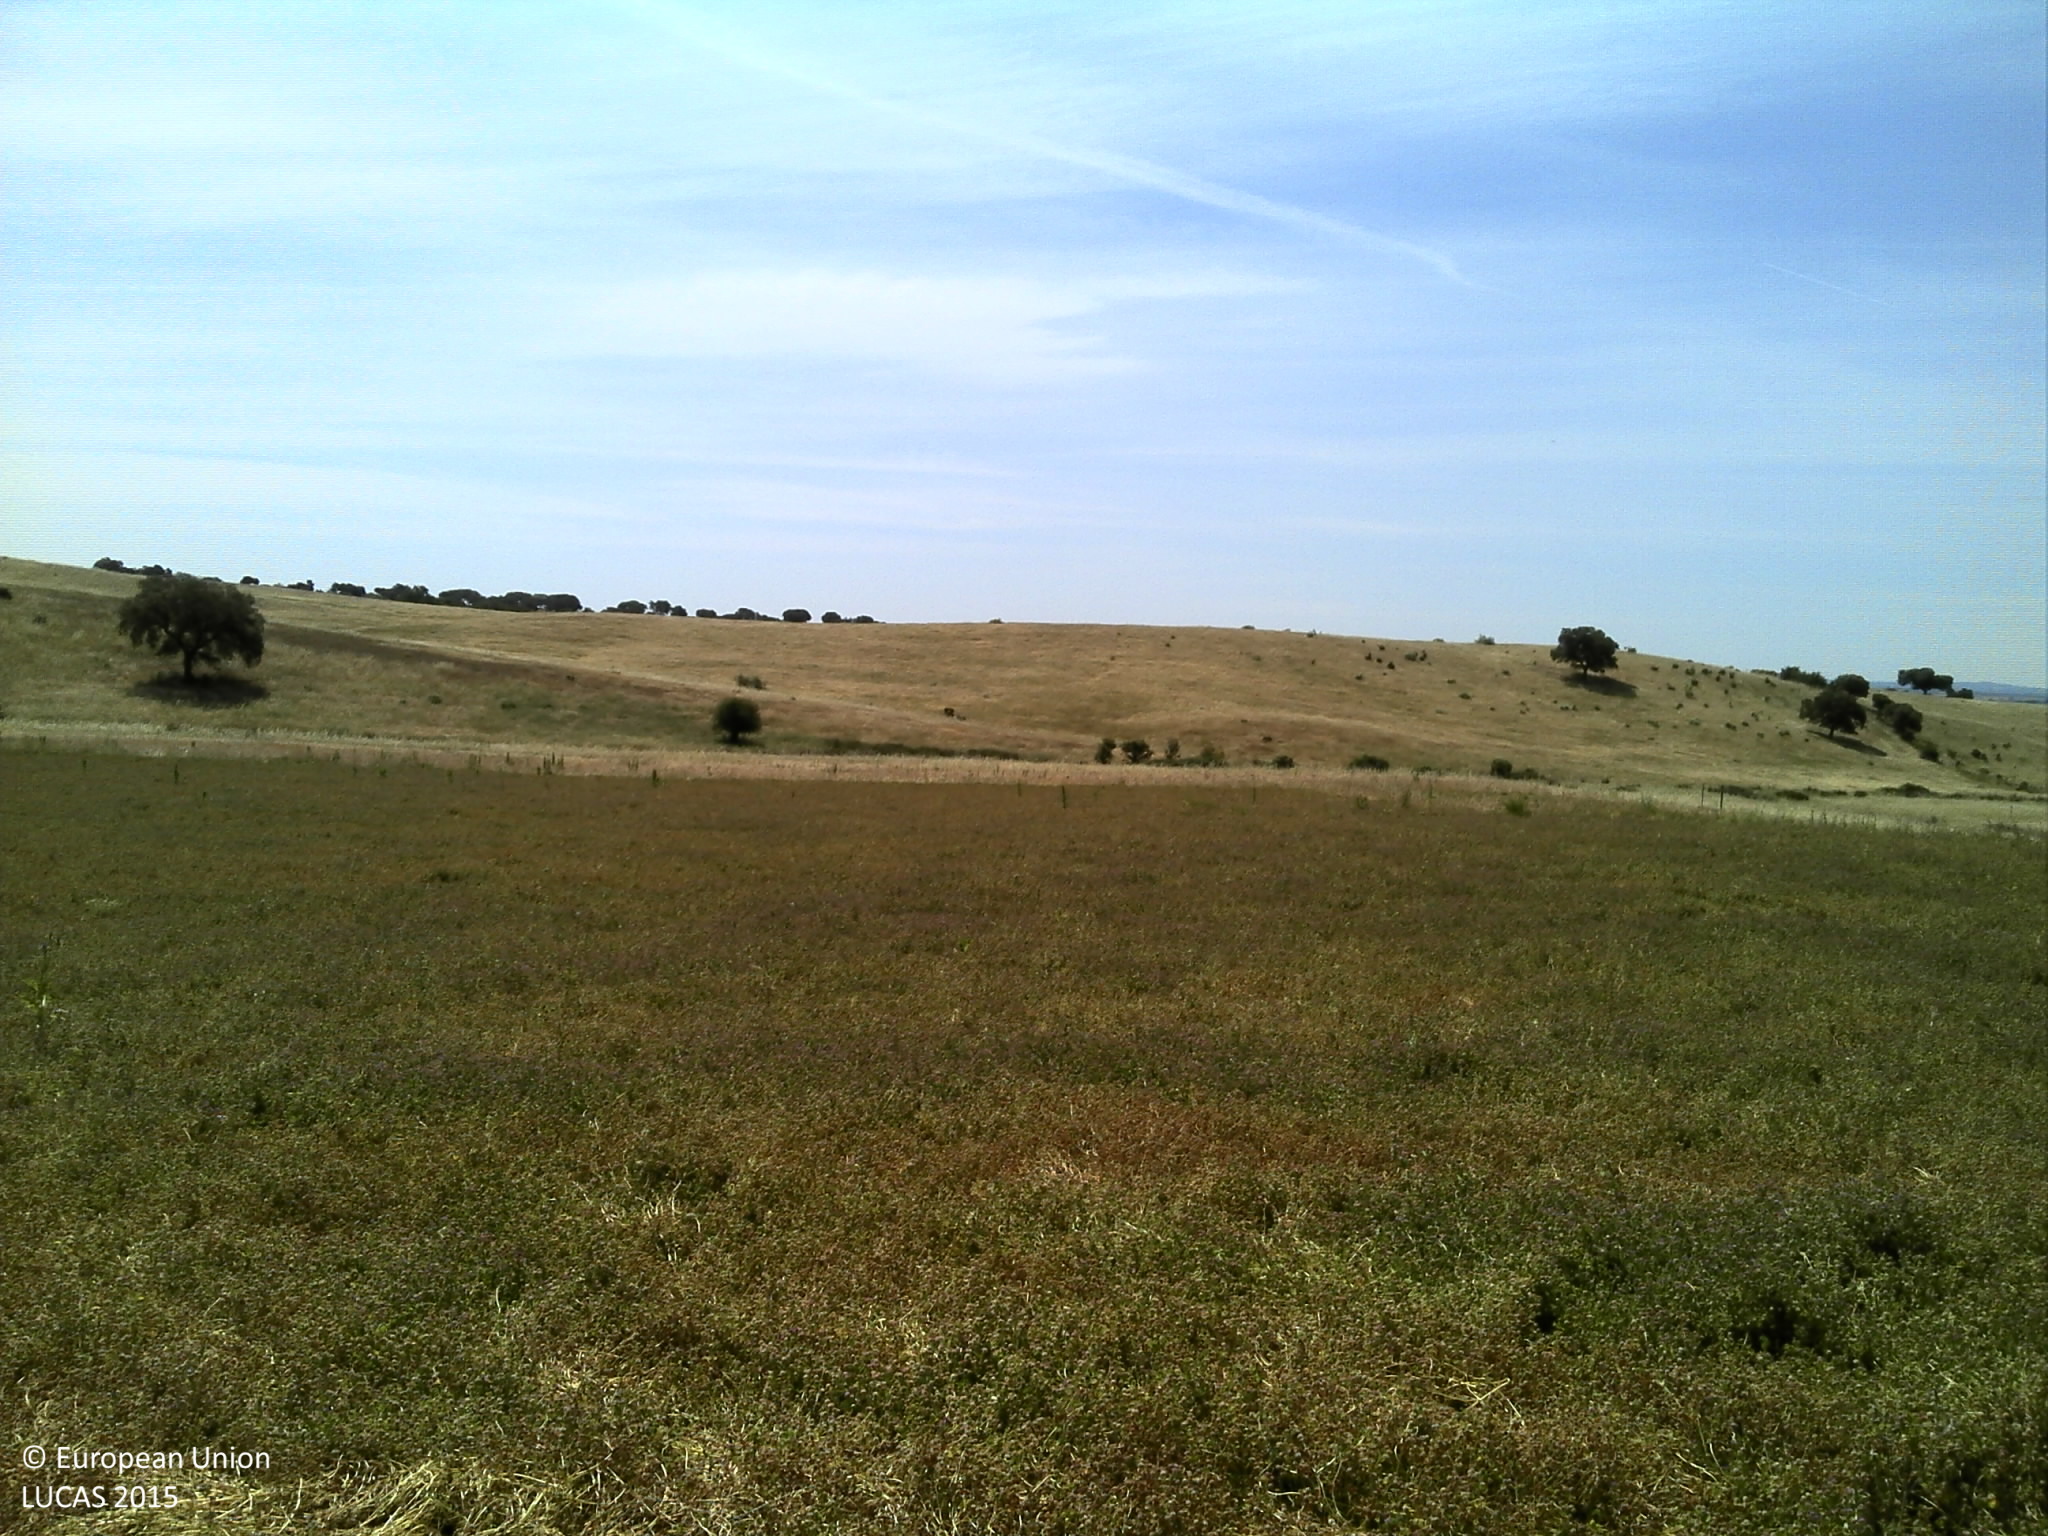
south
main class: Cropland
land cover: Clovers
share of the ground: > 75 %
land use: Agriculture (excluding fallow land and kitchen gardens)
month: May
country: PT
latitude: 39.0864
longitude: -7.6026
